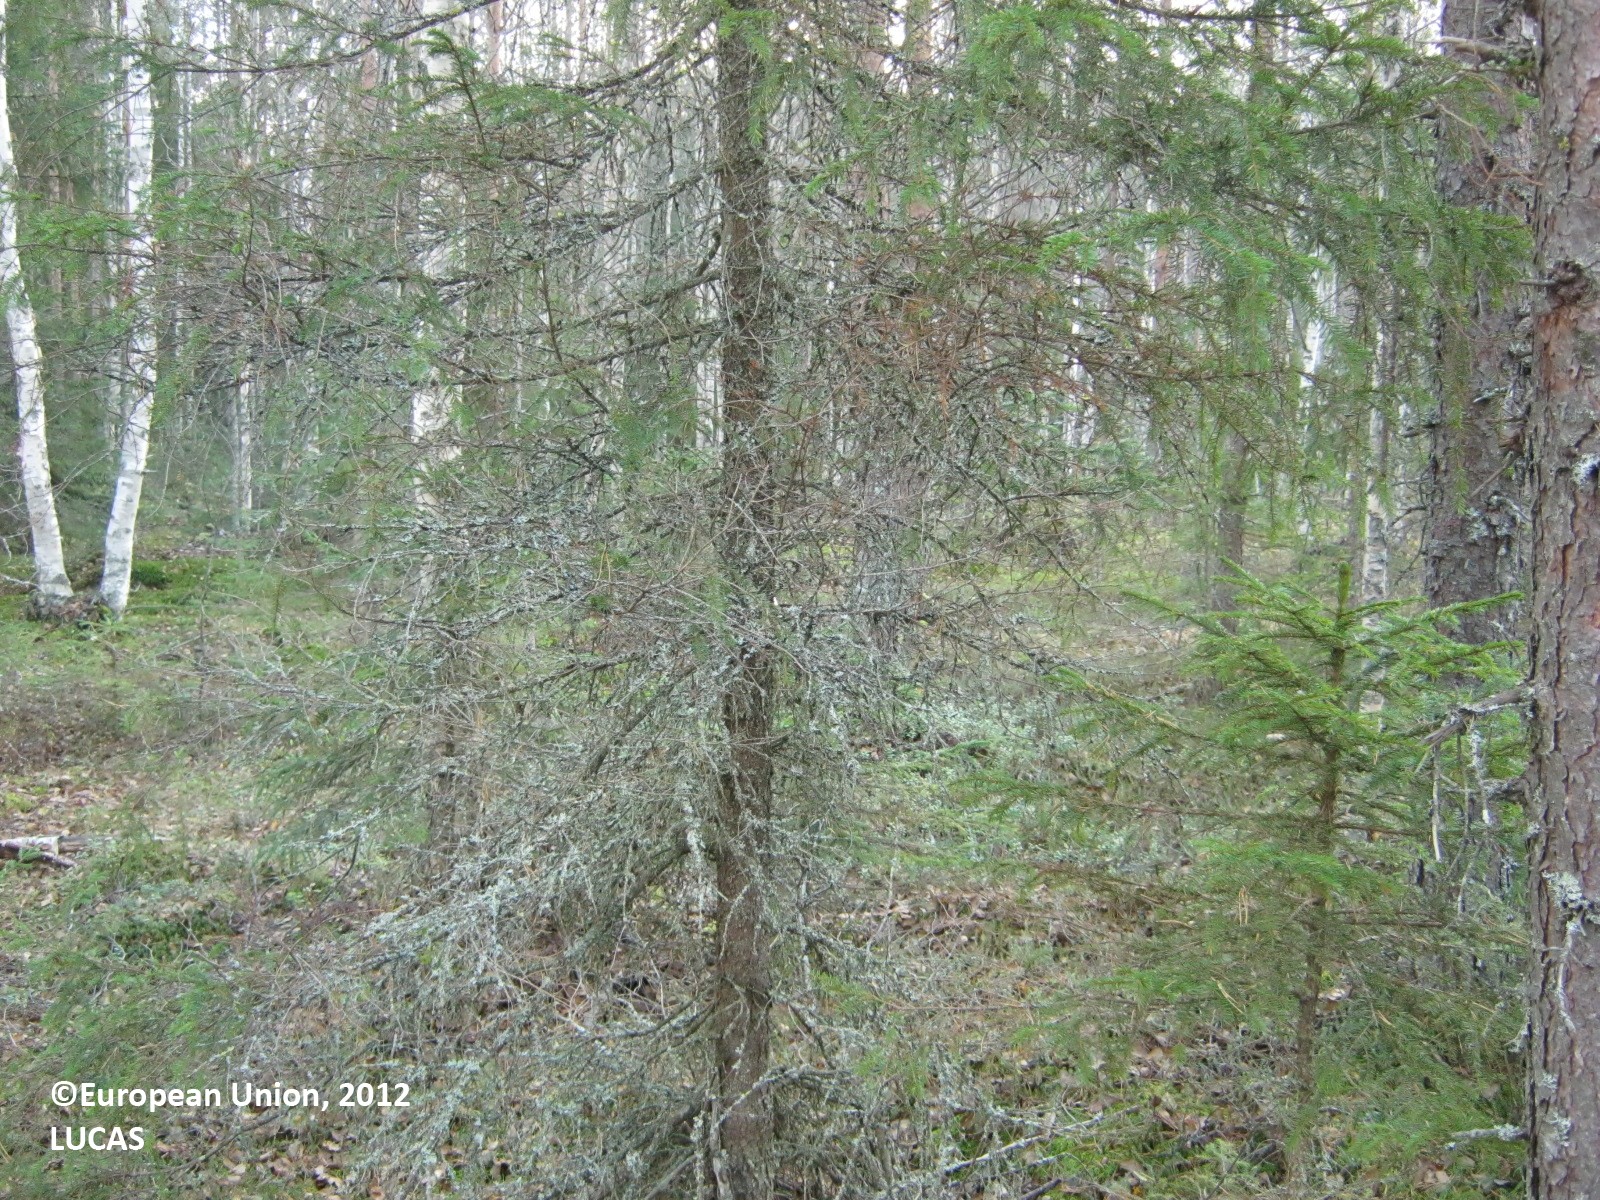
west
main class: Woodland
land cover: Other mixed woodland
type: boreal forest
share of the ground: > 75 %
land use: Forestry
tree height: > 5 m
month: September
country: FI
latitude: 63.5037
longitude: 26.0052
